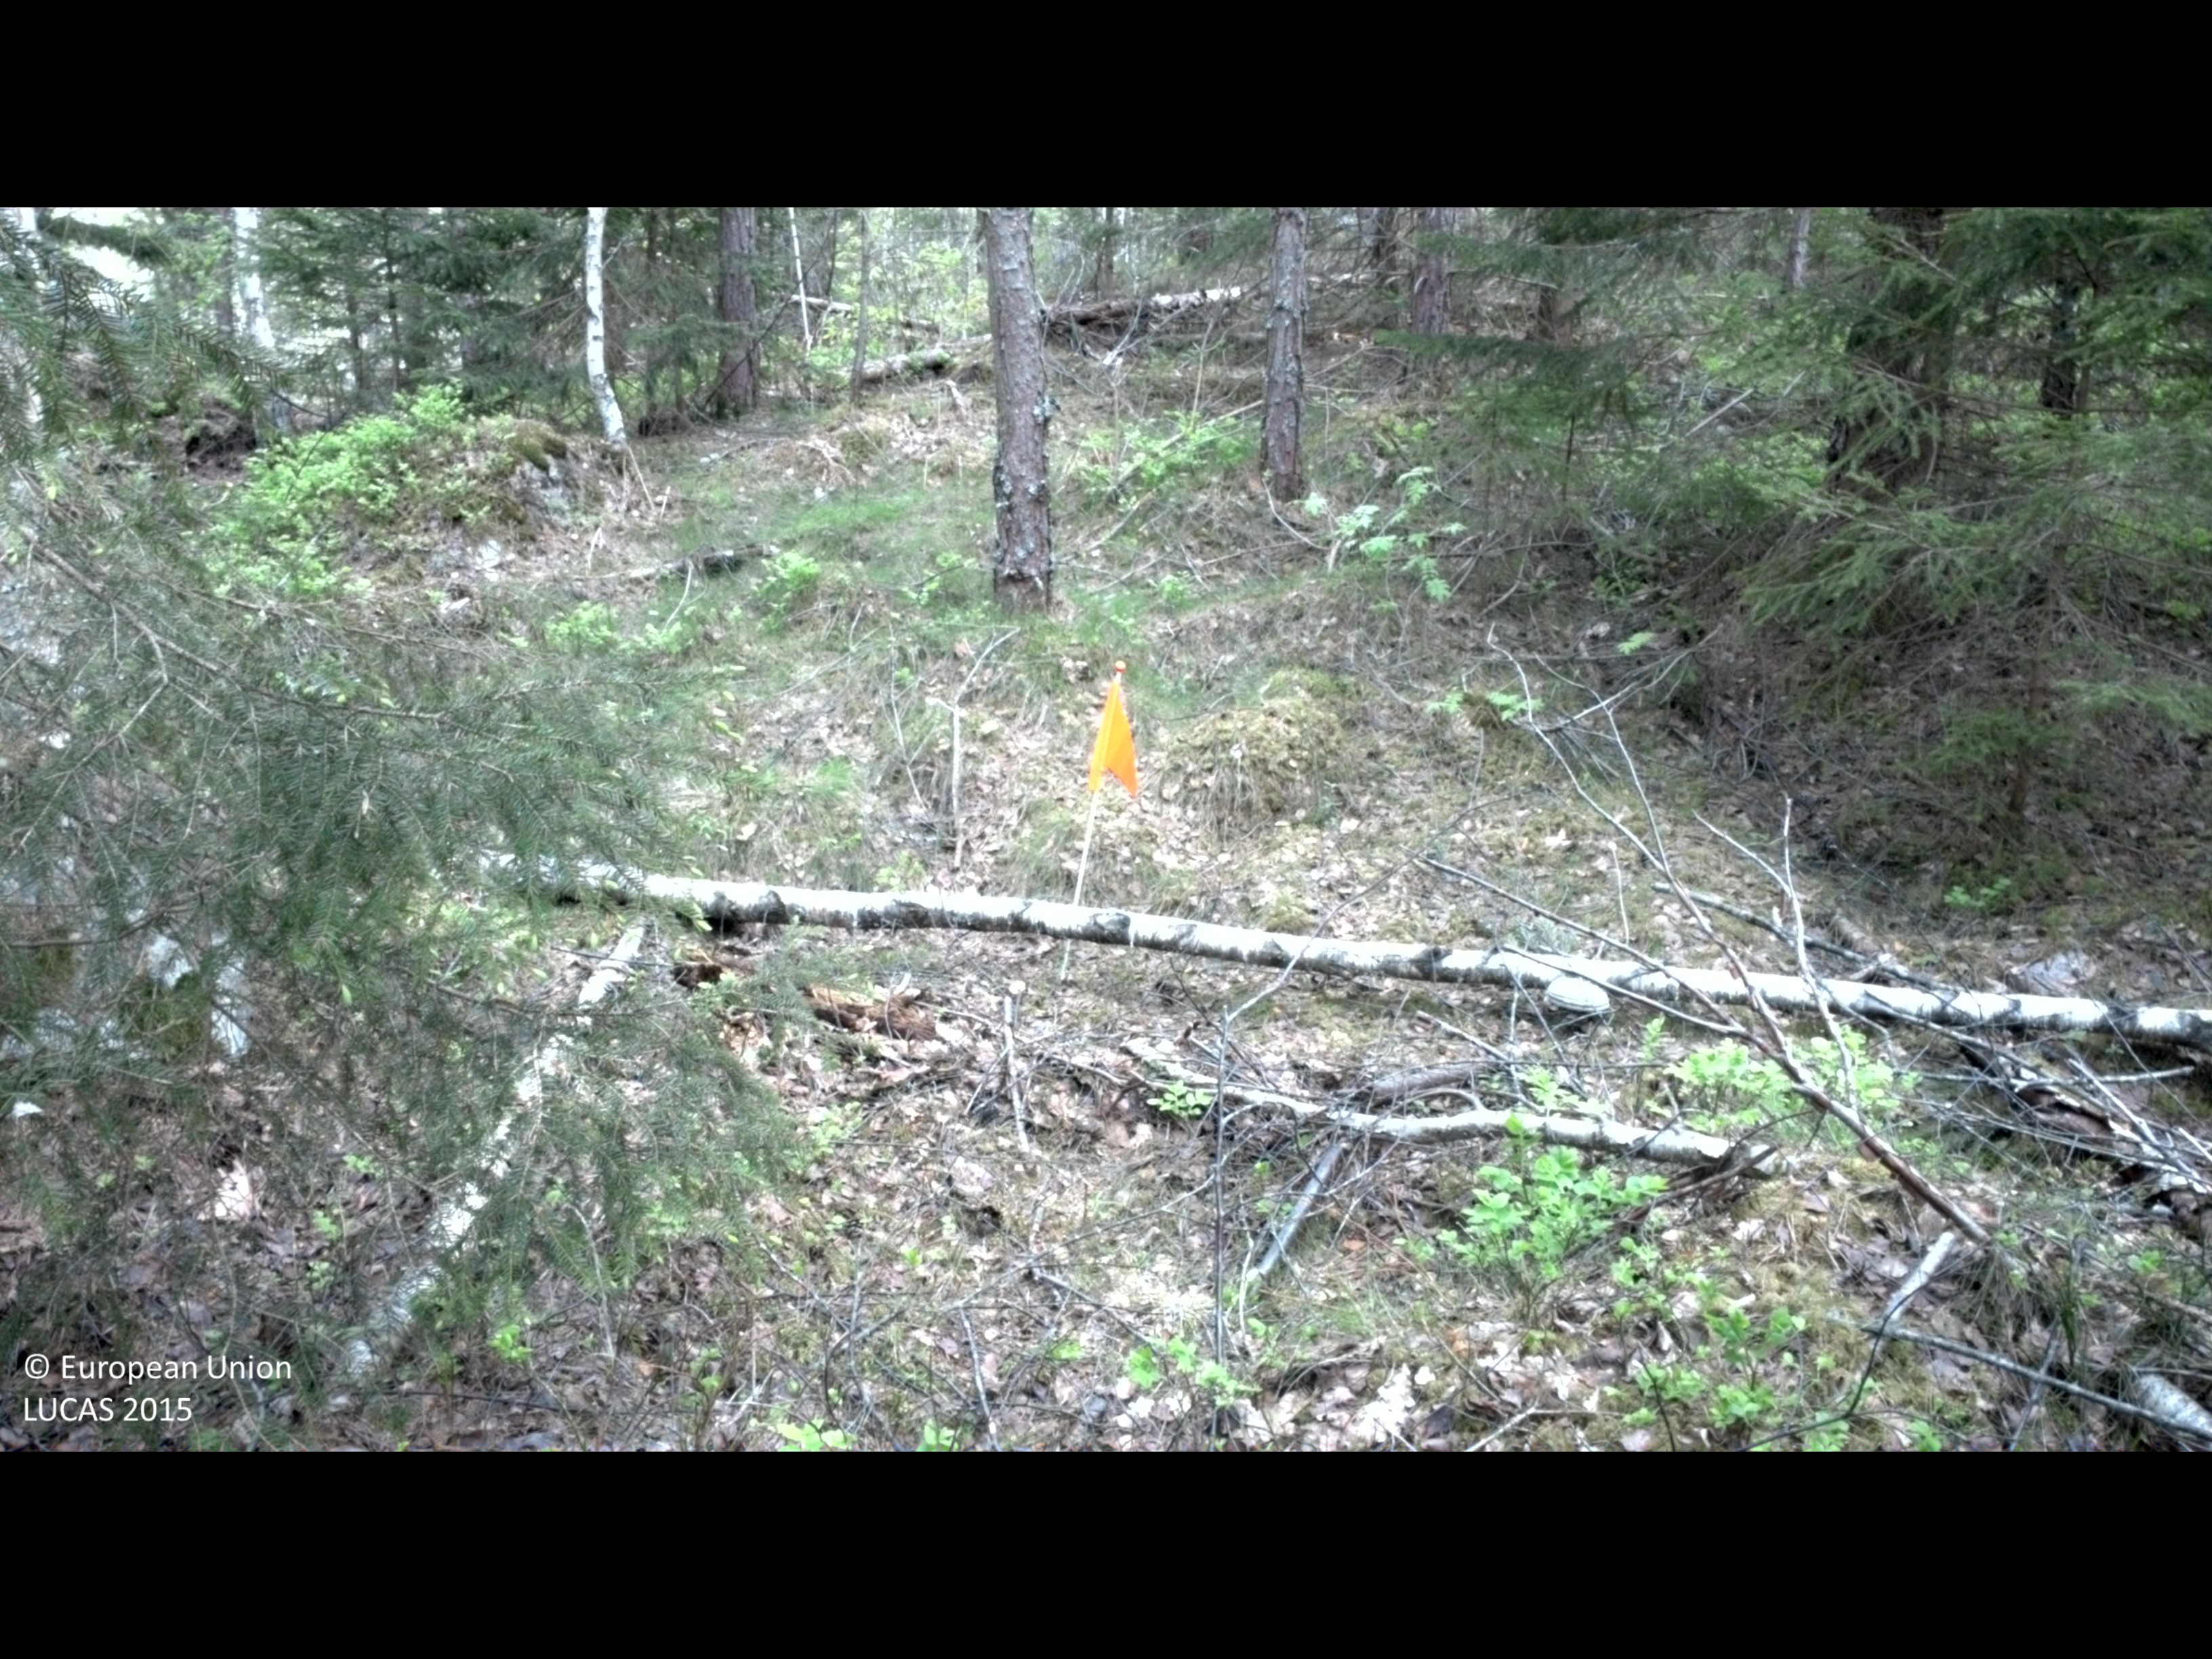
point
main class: Woodland
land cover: Pine dominated mixed woodland
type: boreal forest
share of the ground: > 75 %
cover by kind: coniferous forest trees 60 %, broadleaved forest trees 20 %, shrubs 10 %, lichens and mosses 10 %
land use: Forestry
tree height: > 5 m
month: May
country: SE
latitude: 57.3221
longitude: 16.1264
